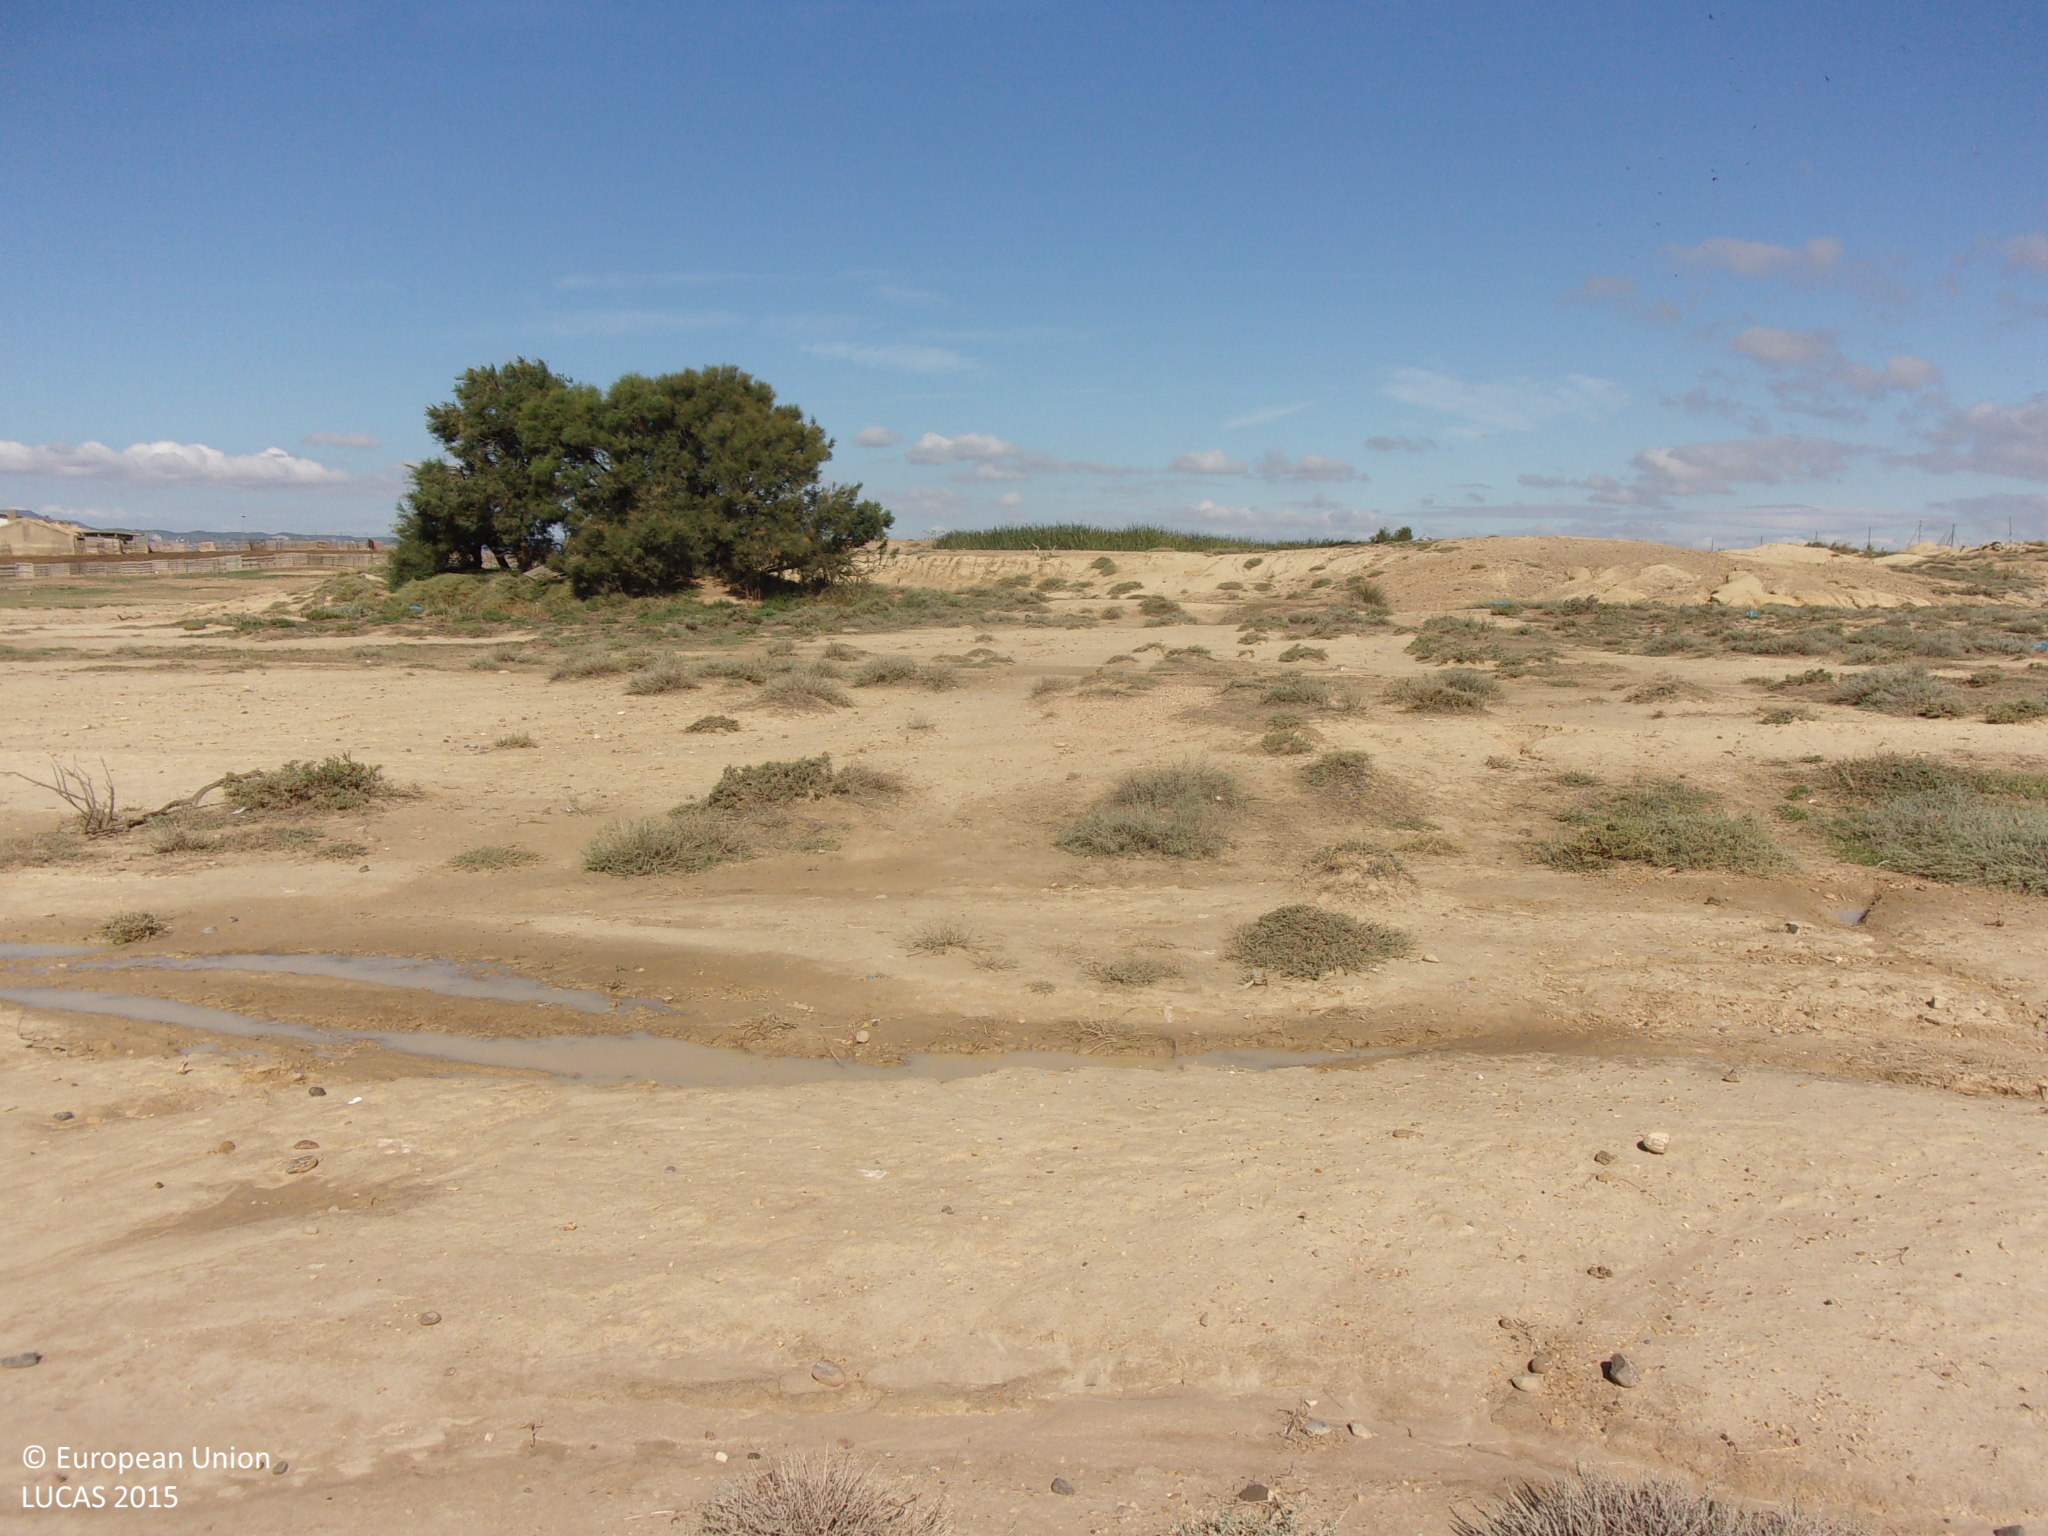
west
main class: Shrubland
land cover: Shrubland without tree cover
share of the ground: 10 - 25 %
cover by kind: consolidated bare surface 90 %, shrubs 10 %
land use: Abandoned areas
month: August
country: ES
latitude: 42.0923
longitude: -1.1388
